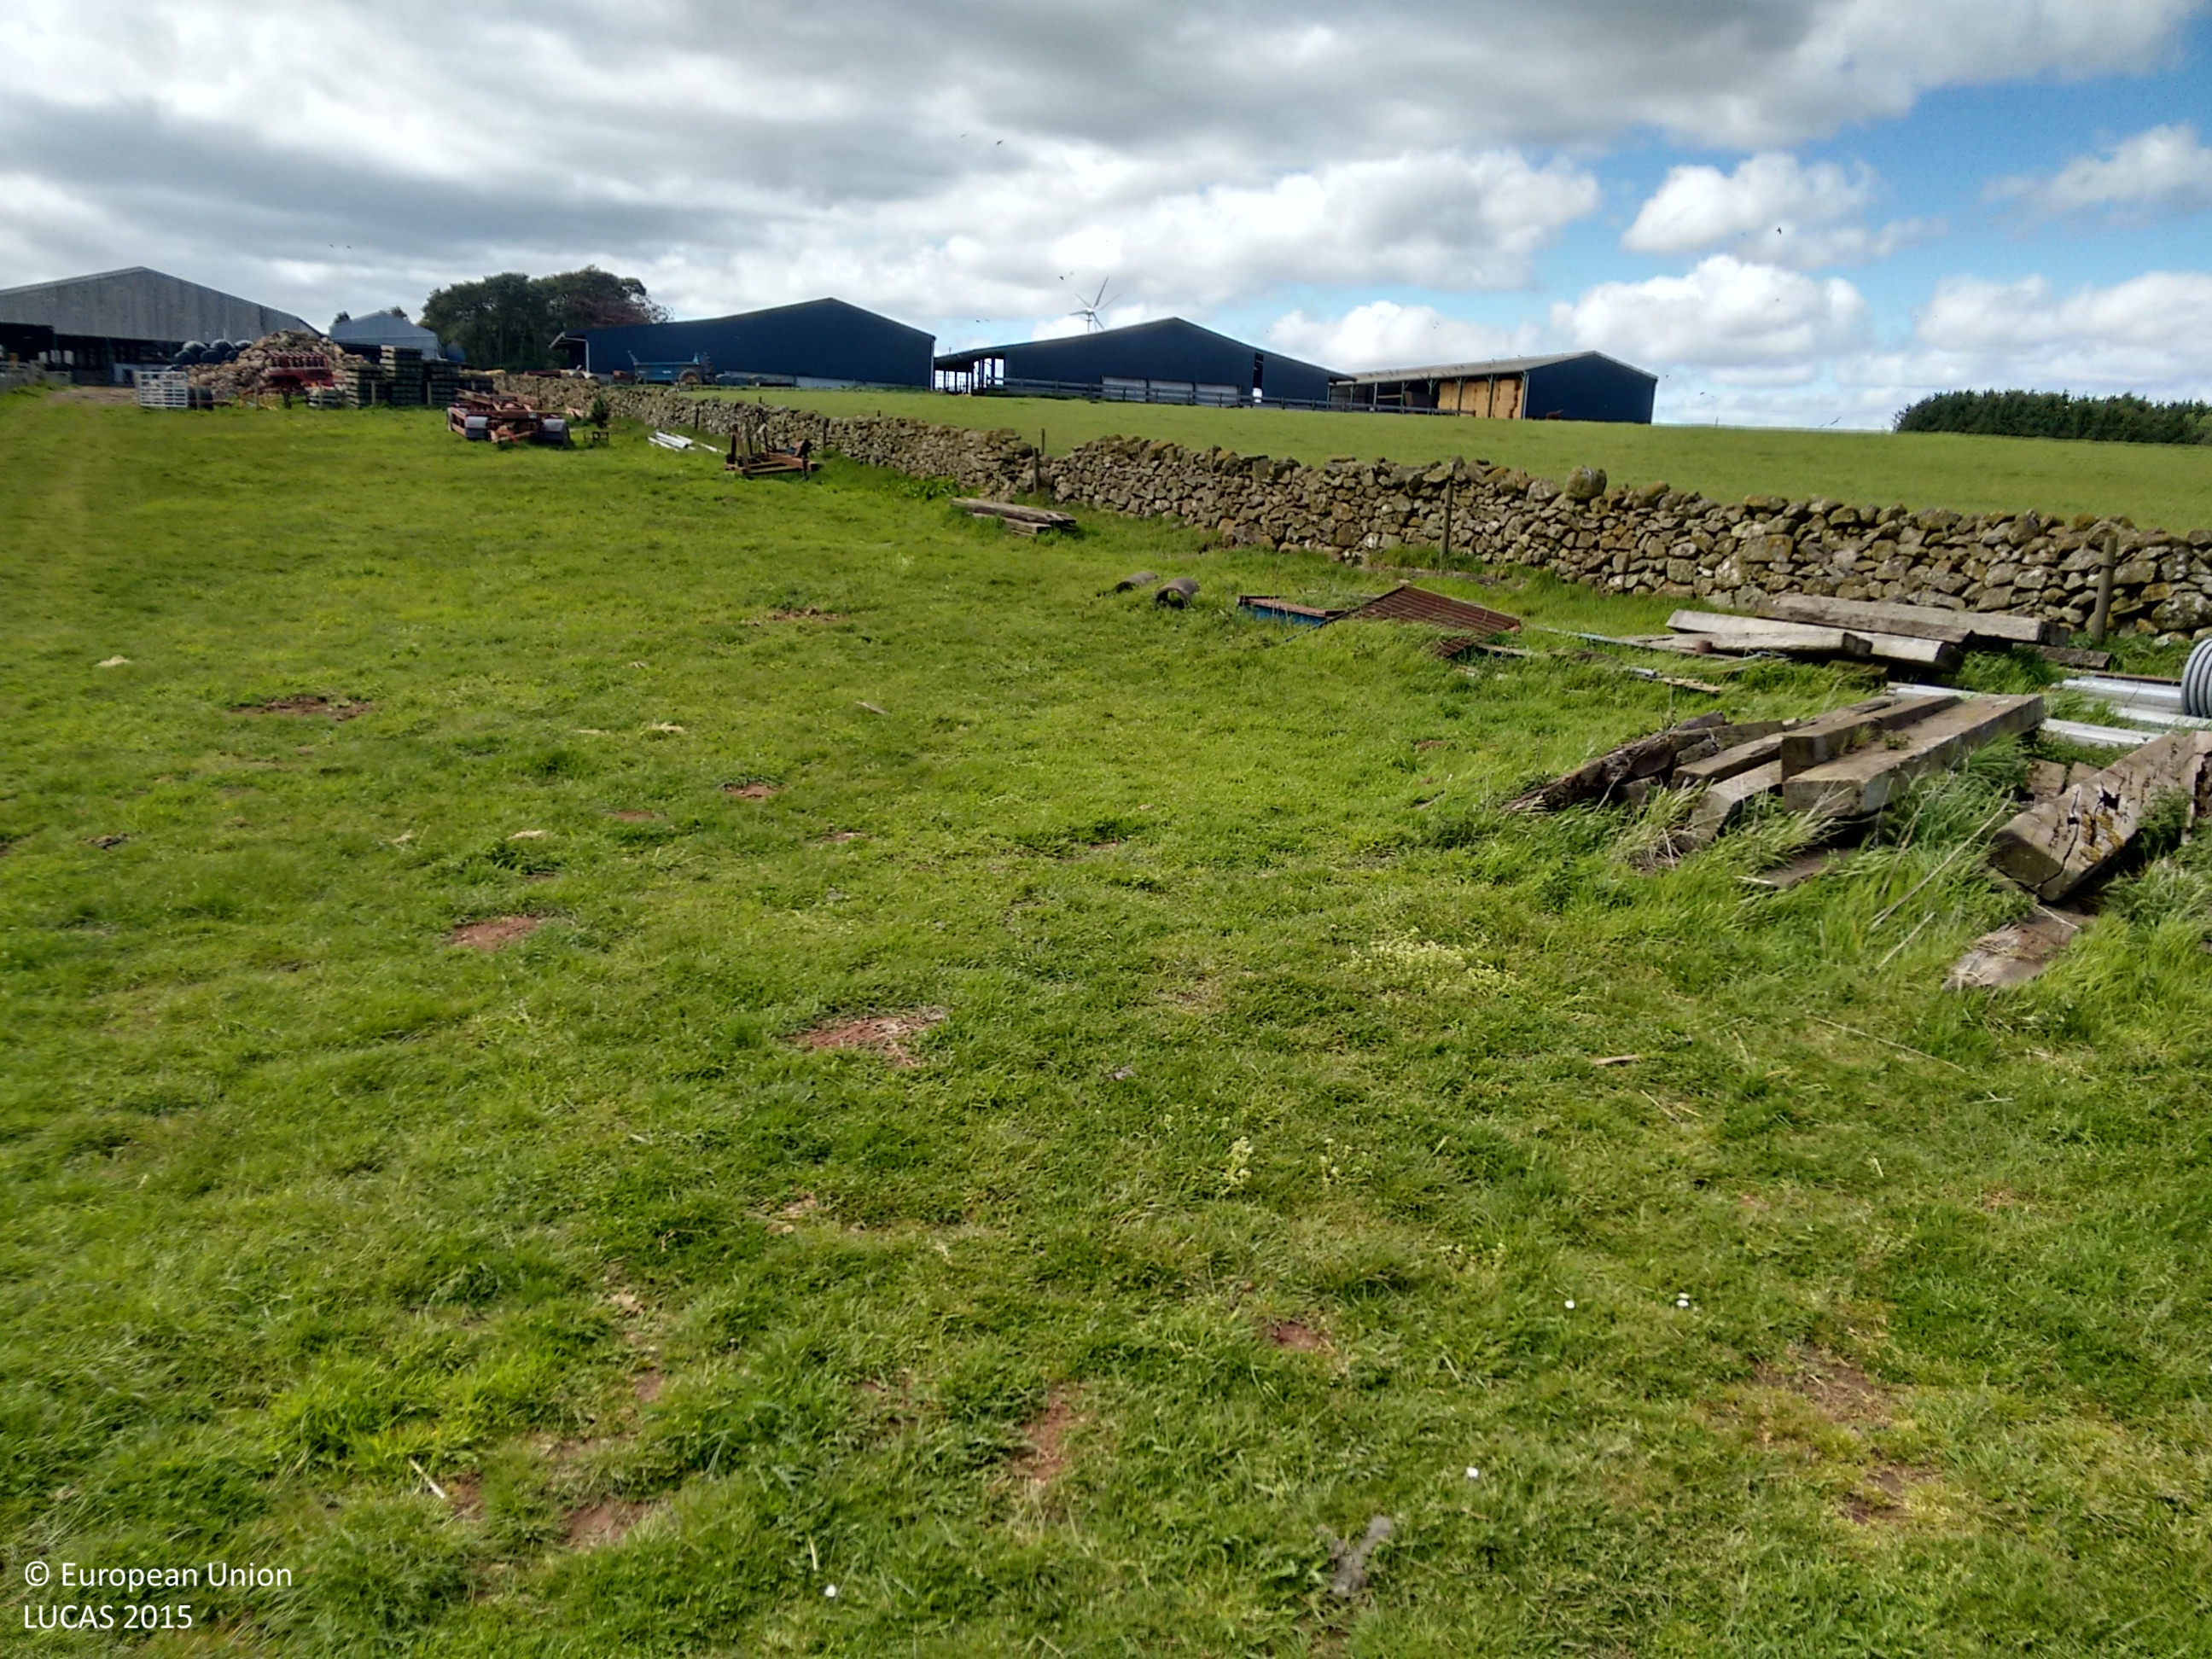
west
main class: Grassland
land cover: Grassland without tree/shrub cover
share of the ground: > 75 %
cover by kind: herbaceous plants 100 %
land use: Agriculture (excluding fallow land and kitchen gardens)
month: June
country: GB
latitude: 55.7023
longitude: -2.4877
